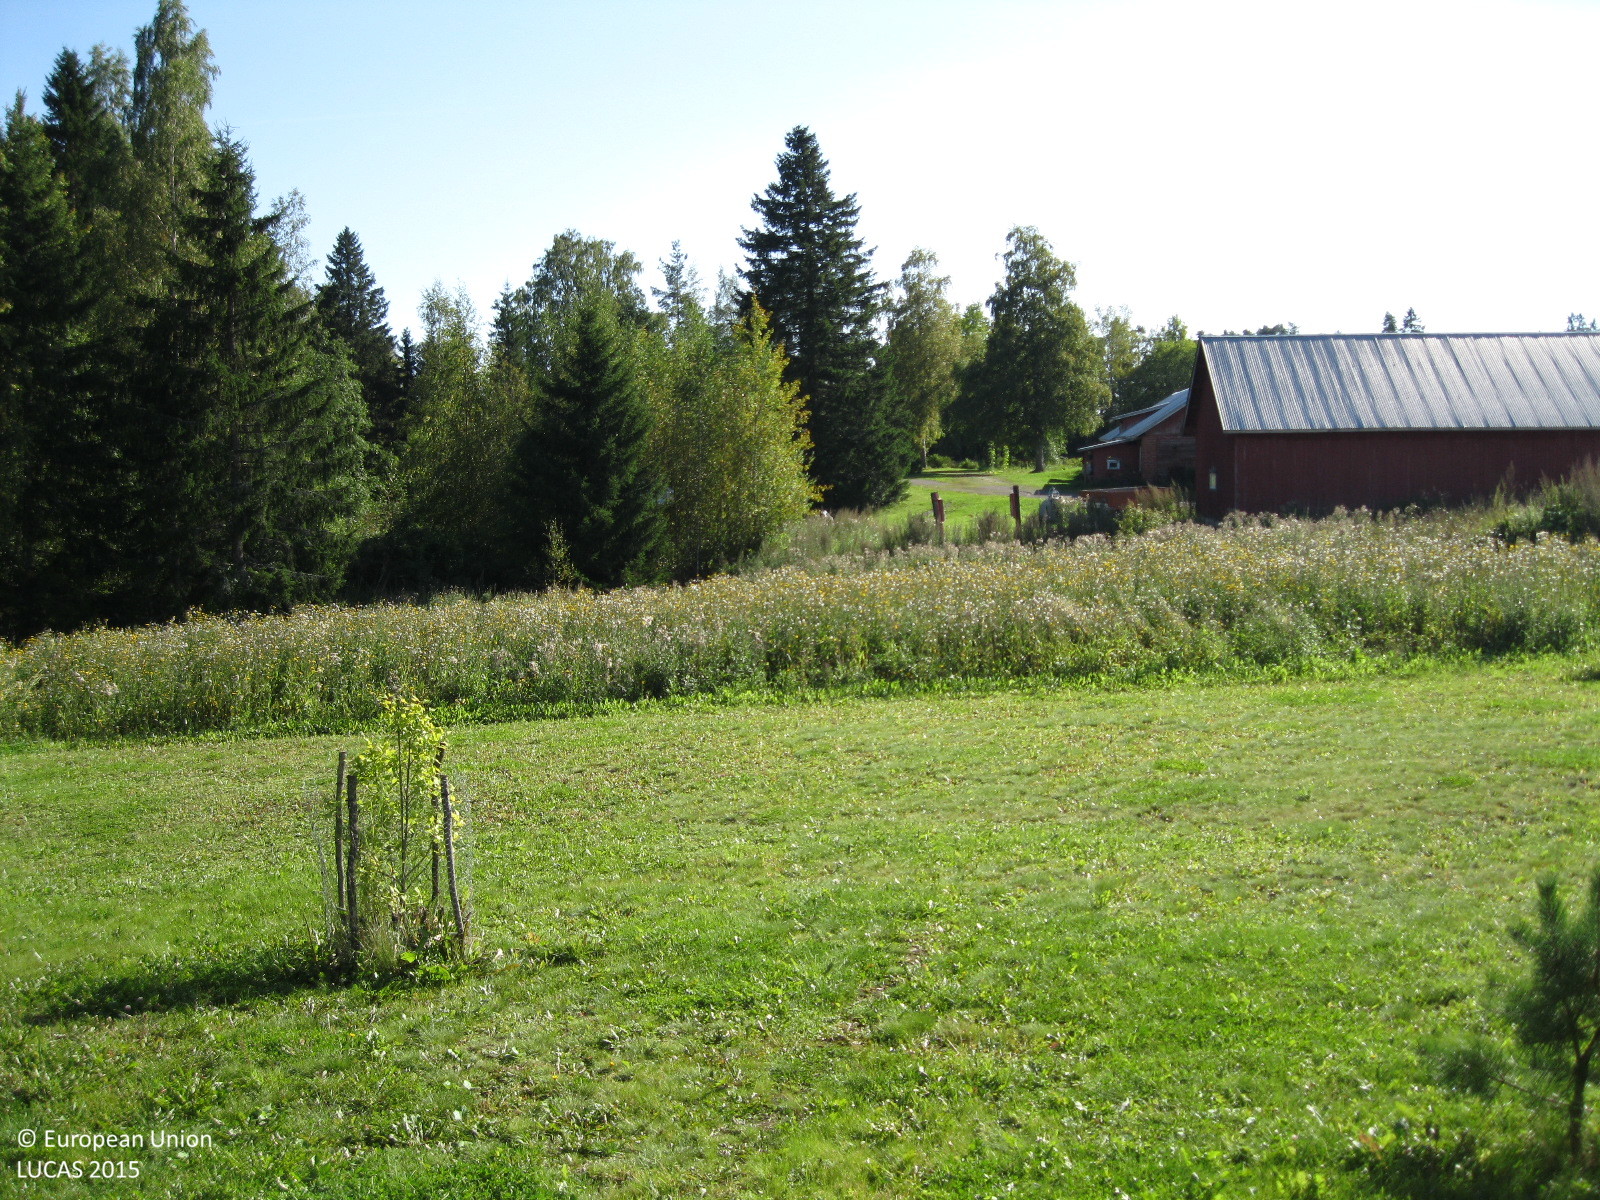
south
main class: Grassland
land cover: Grassland with sparse tree/shrub cover
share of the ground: > 75 %
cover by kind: herbaceous plants 95 %, coniferous forest trees 5 %
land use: Residential
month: September
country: FI
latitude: 60.6595
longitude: 24.9901
